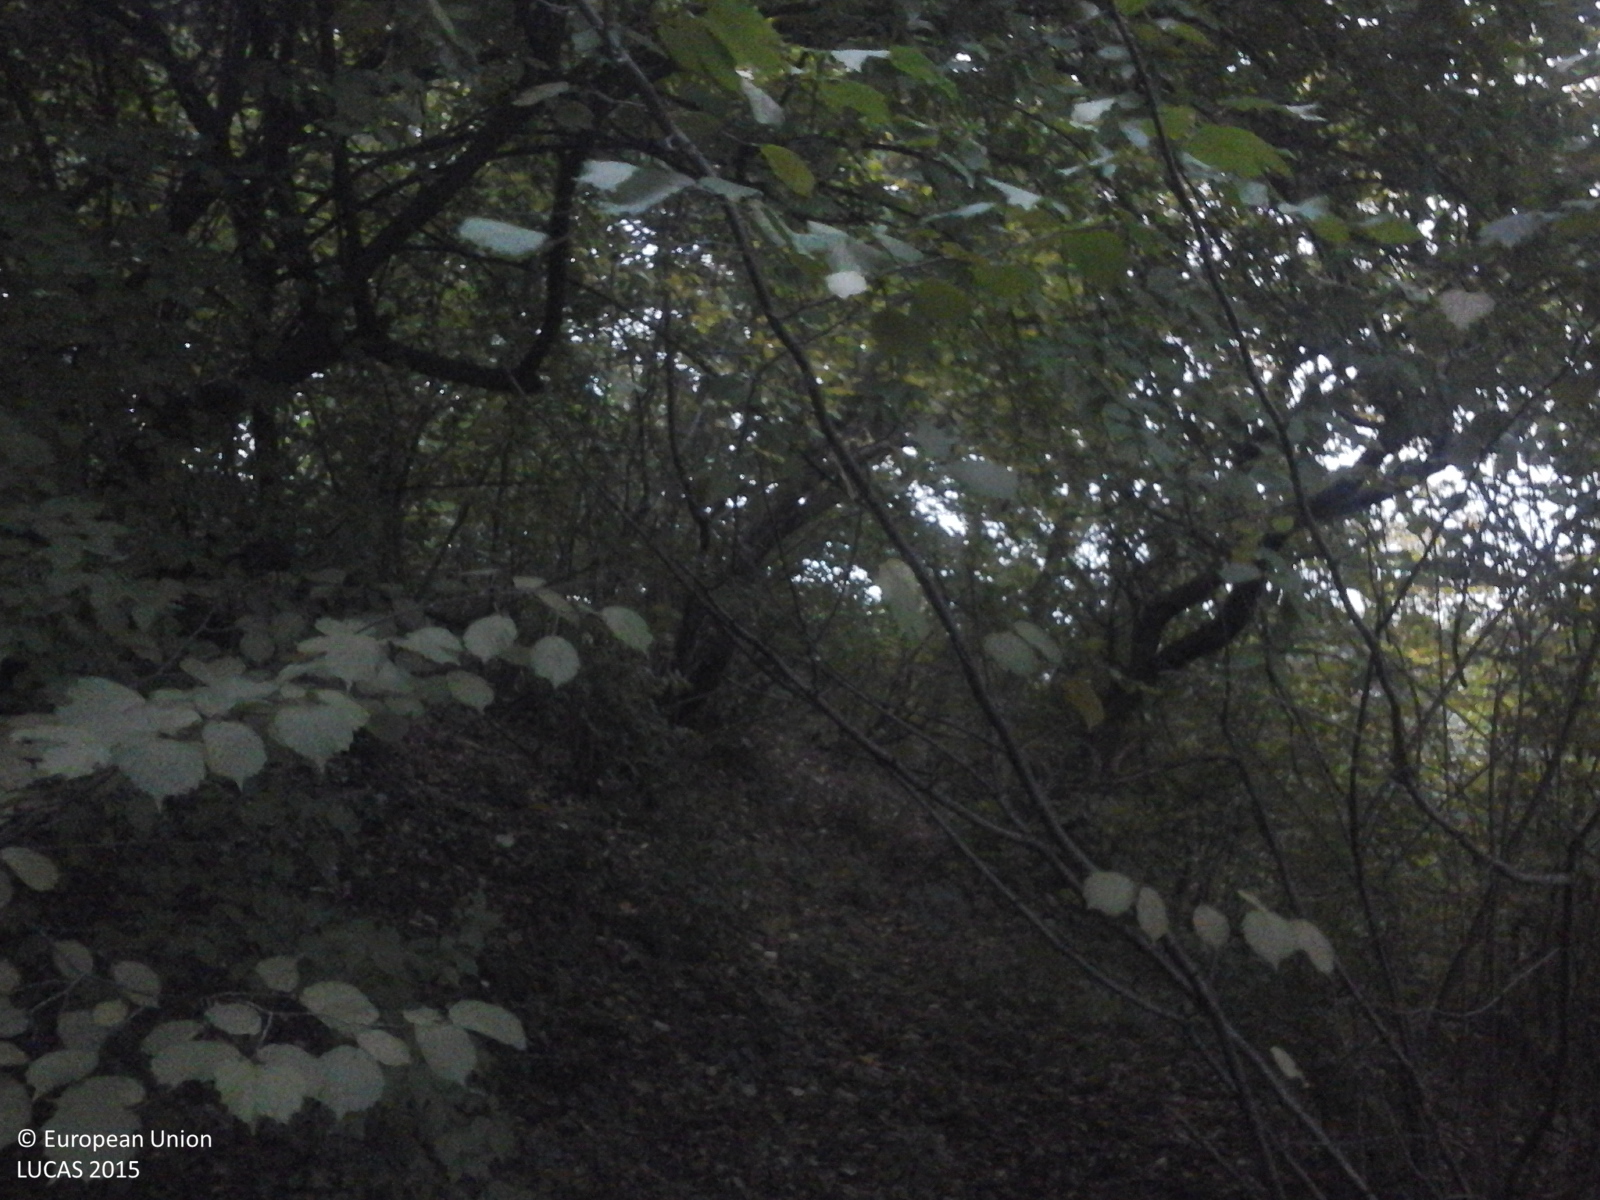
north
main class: Woodland
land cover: Broadleaved woodland
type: beech forest
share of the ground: > 75 %
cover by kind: broadleaved forest trees 100 %
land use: Forestry
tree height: > 5 m
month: October
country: RO
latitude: 46.2899
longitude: 25.2761
